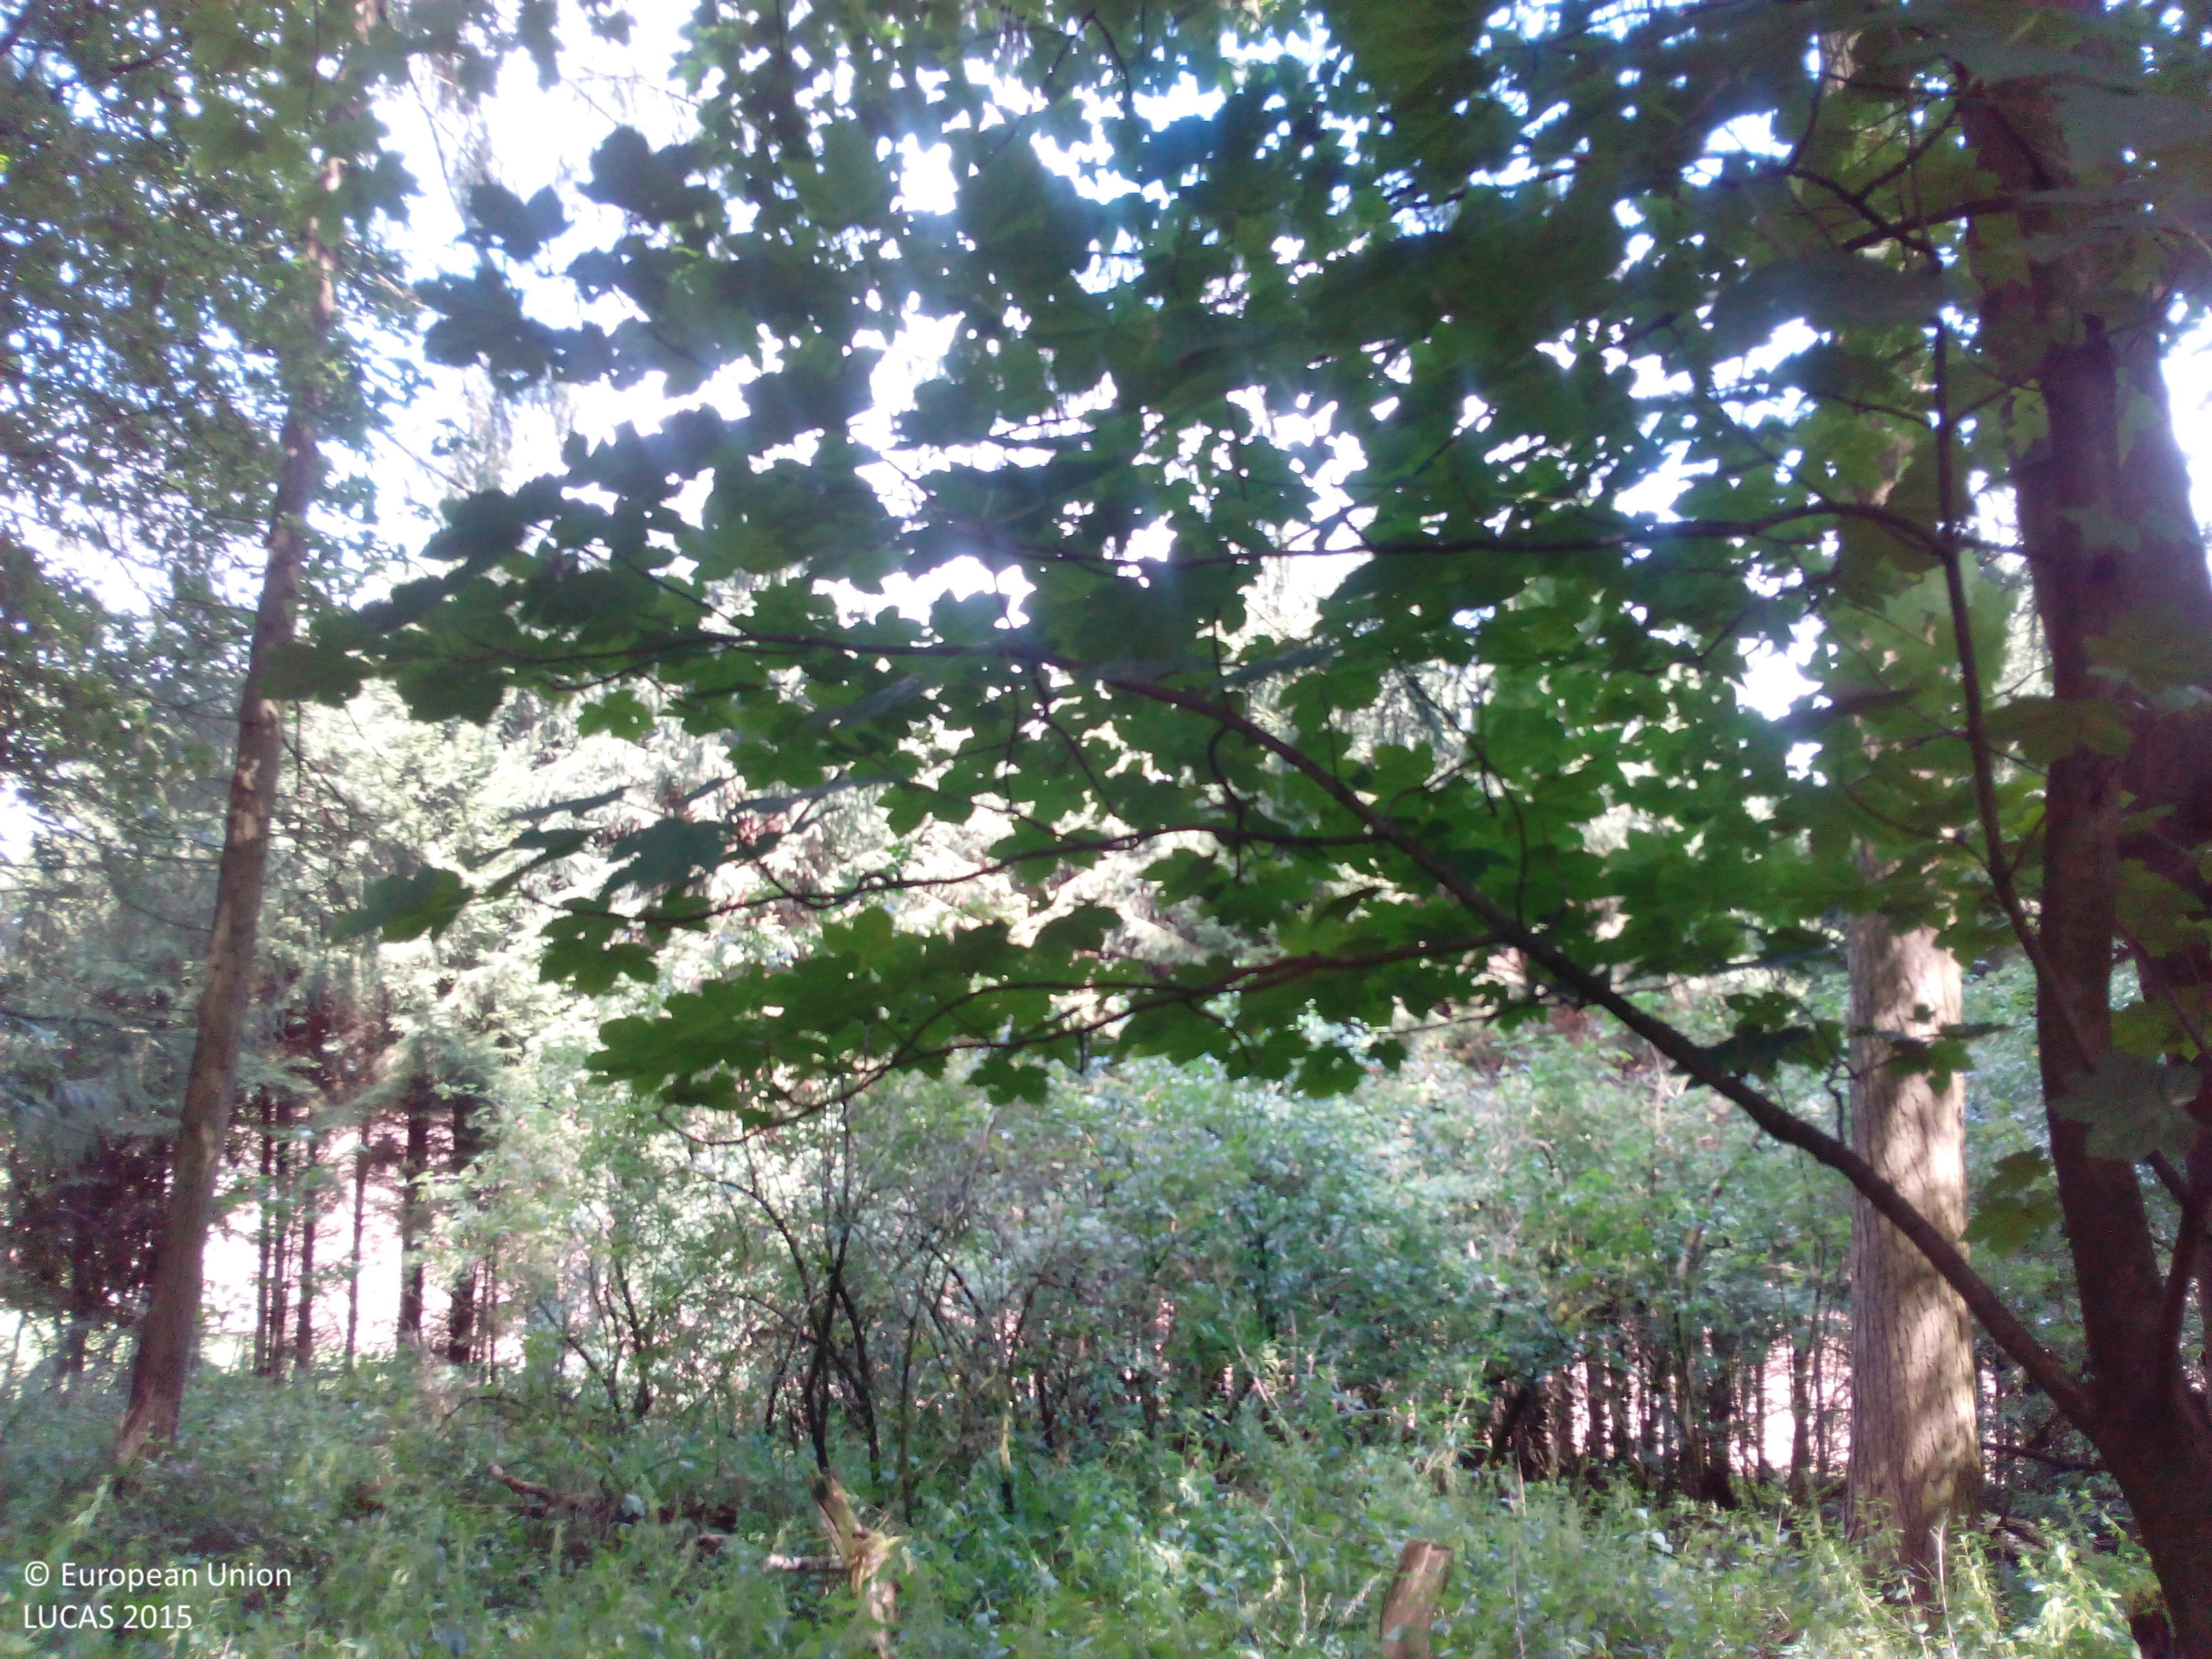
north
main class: Woodland
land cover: Broadleaved woodland
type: mesophytic deciduous forest
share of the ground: > 75 %
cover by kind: broadleaved forest trees 90 %, shrubs 5 %, herbaceous plants 5 %
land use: Forestry
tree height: > 5 m
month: July
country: DE
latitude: 52.2172
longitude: 8.0245
